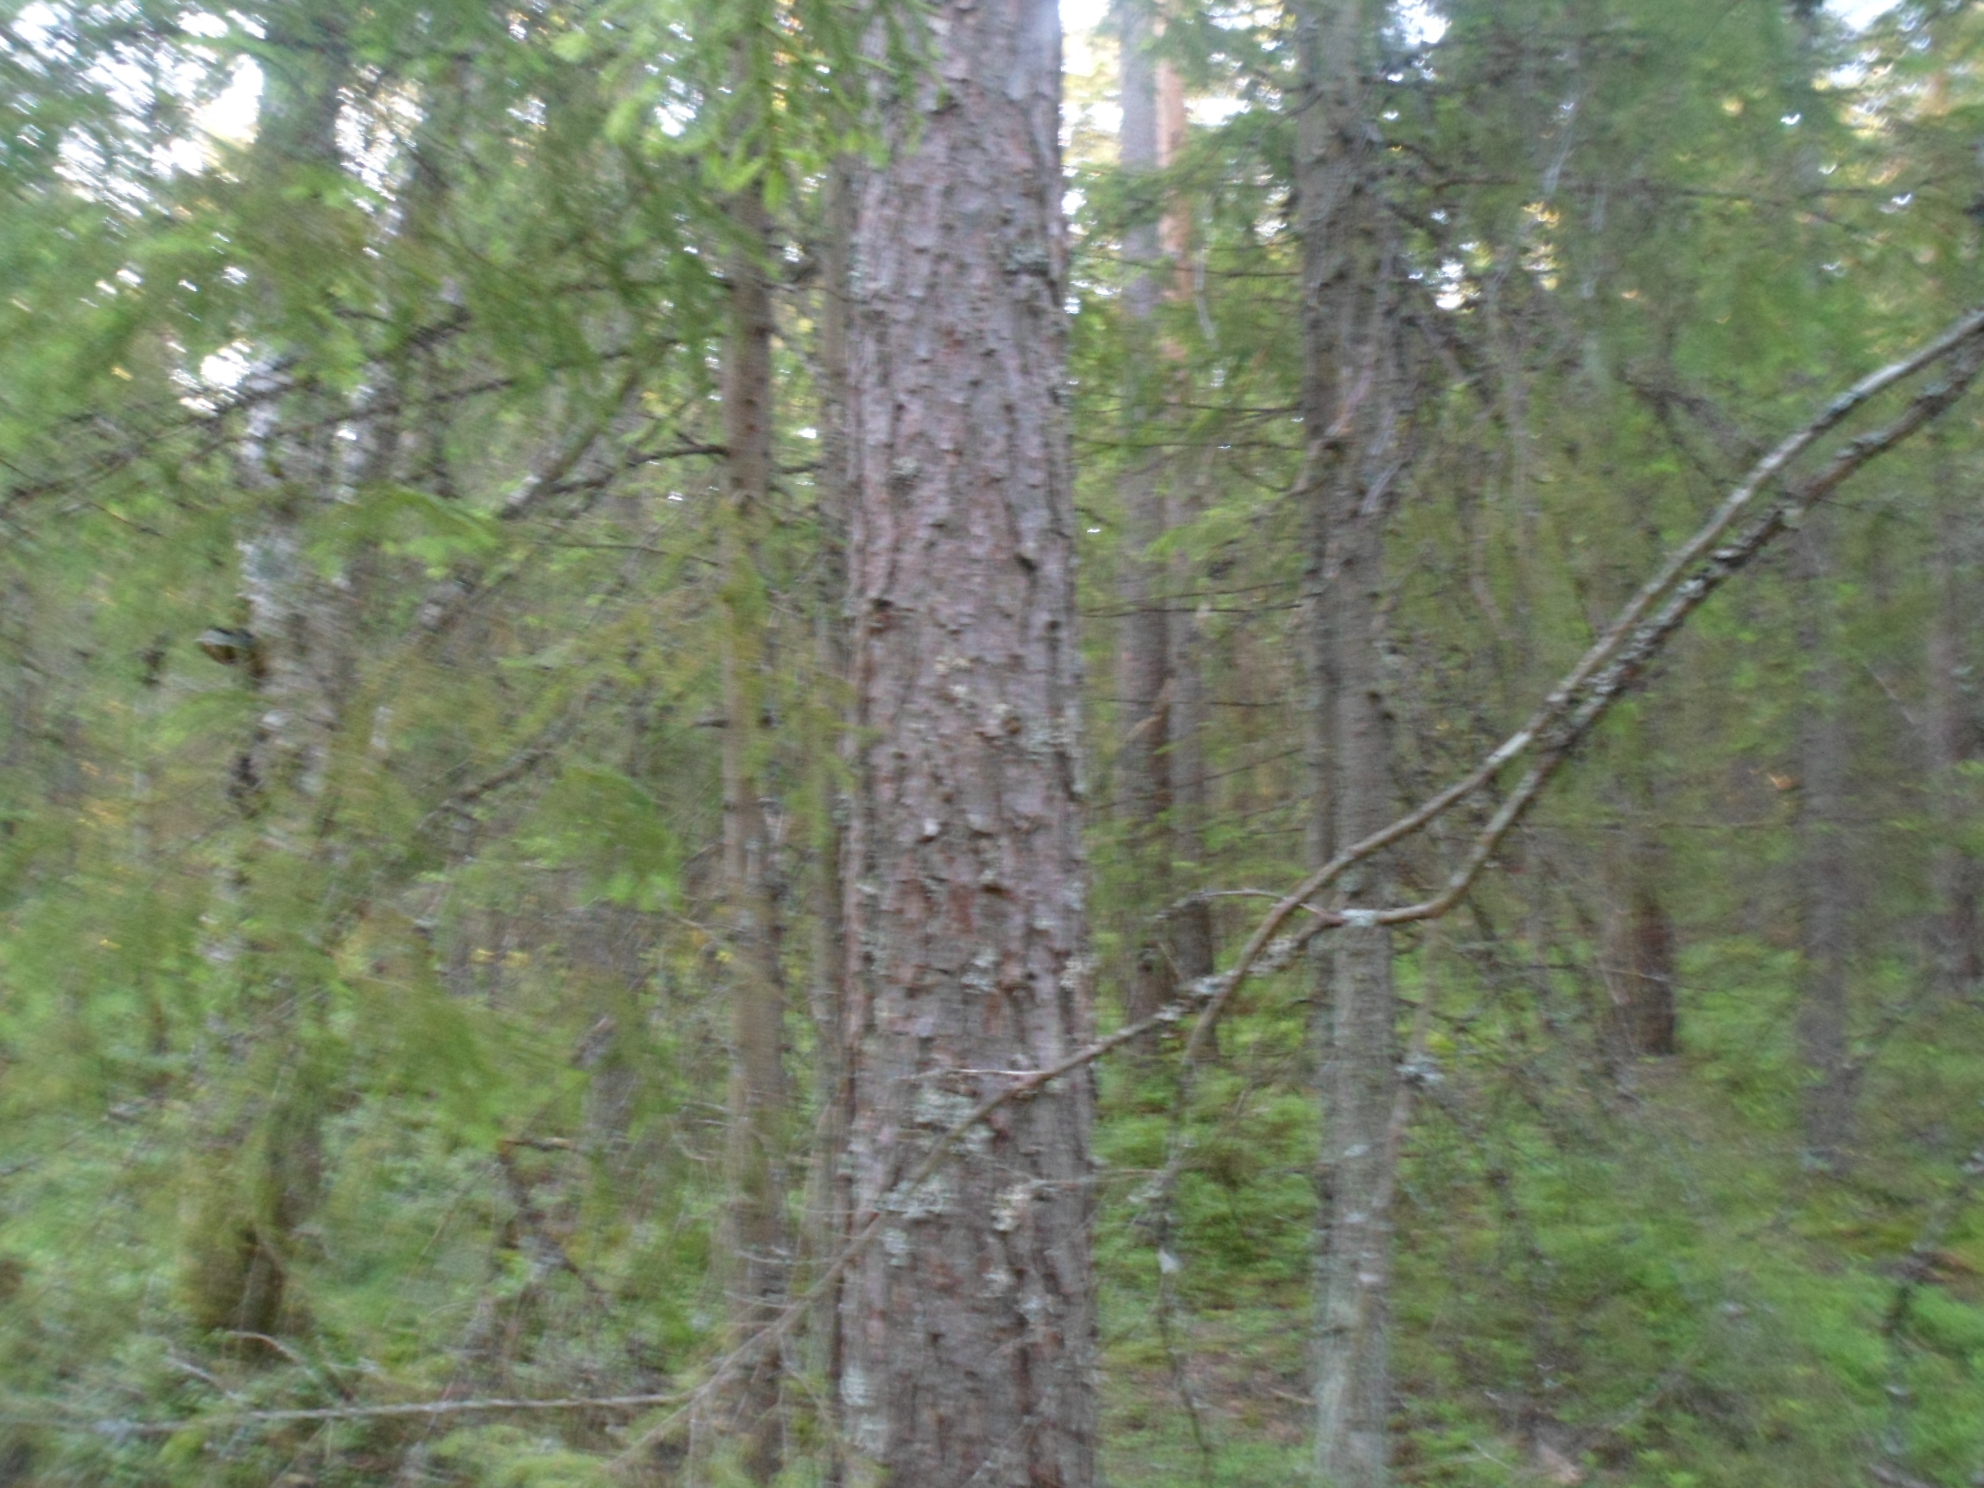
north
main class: Woodland
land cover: Pine dominated coniferous woodland
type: boreal forest
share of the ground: 50 - 75 %
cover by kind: coniferous forest trees 50 %, lichens and mosses 25 %, broadleaved forest trees 10 %, shrubs 10 %, herbaceous plants 5 %
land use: Forestry
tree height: > 5 m
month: July
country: SE
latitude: 57.5164
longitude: 14.4197
